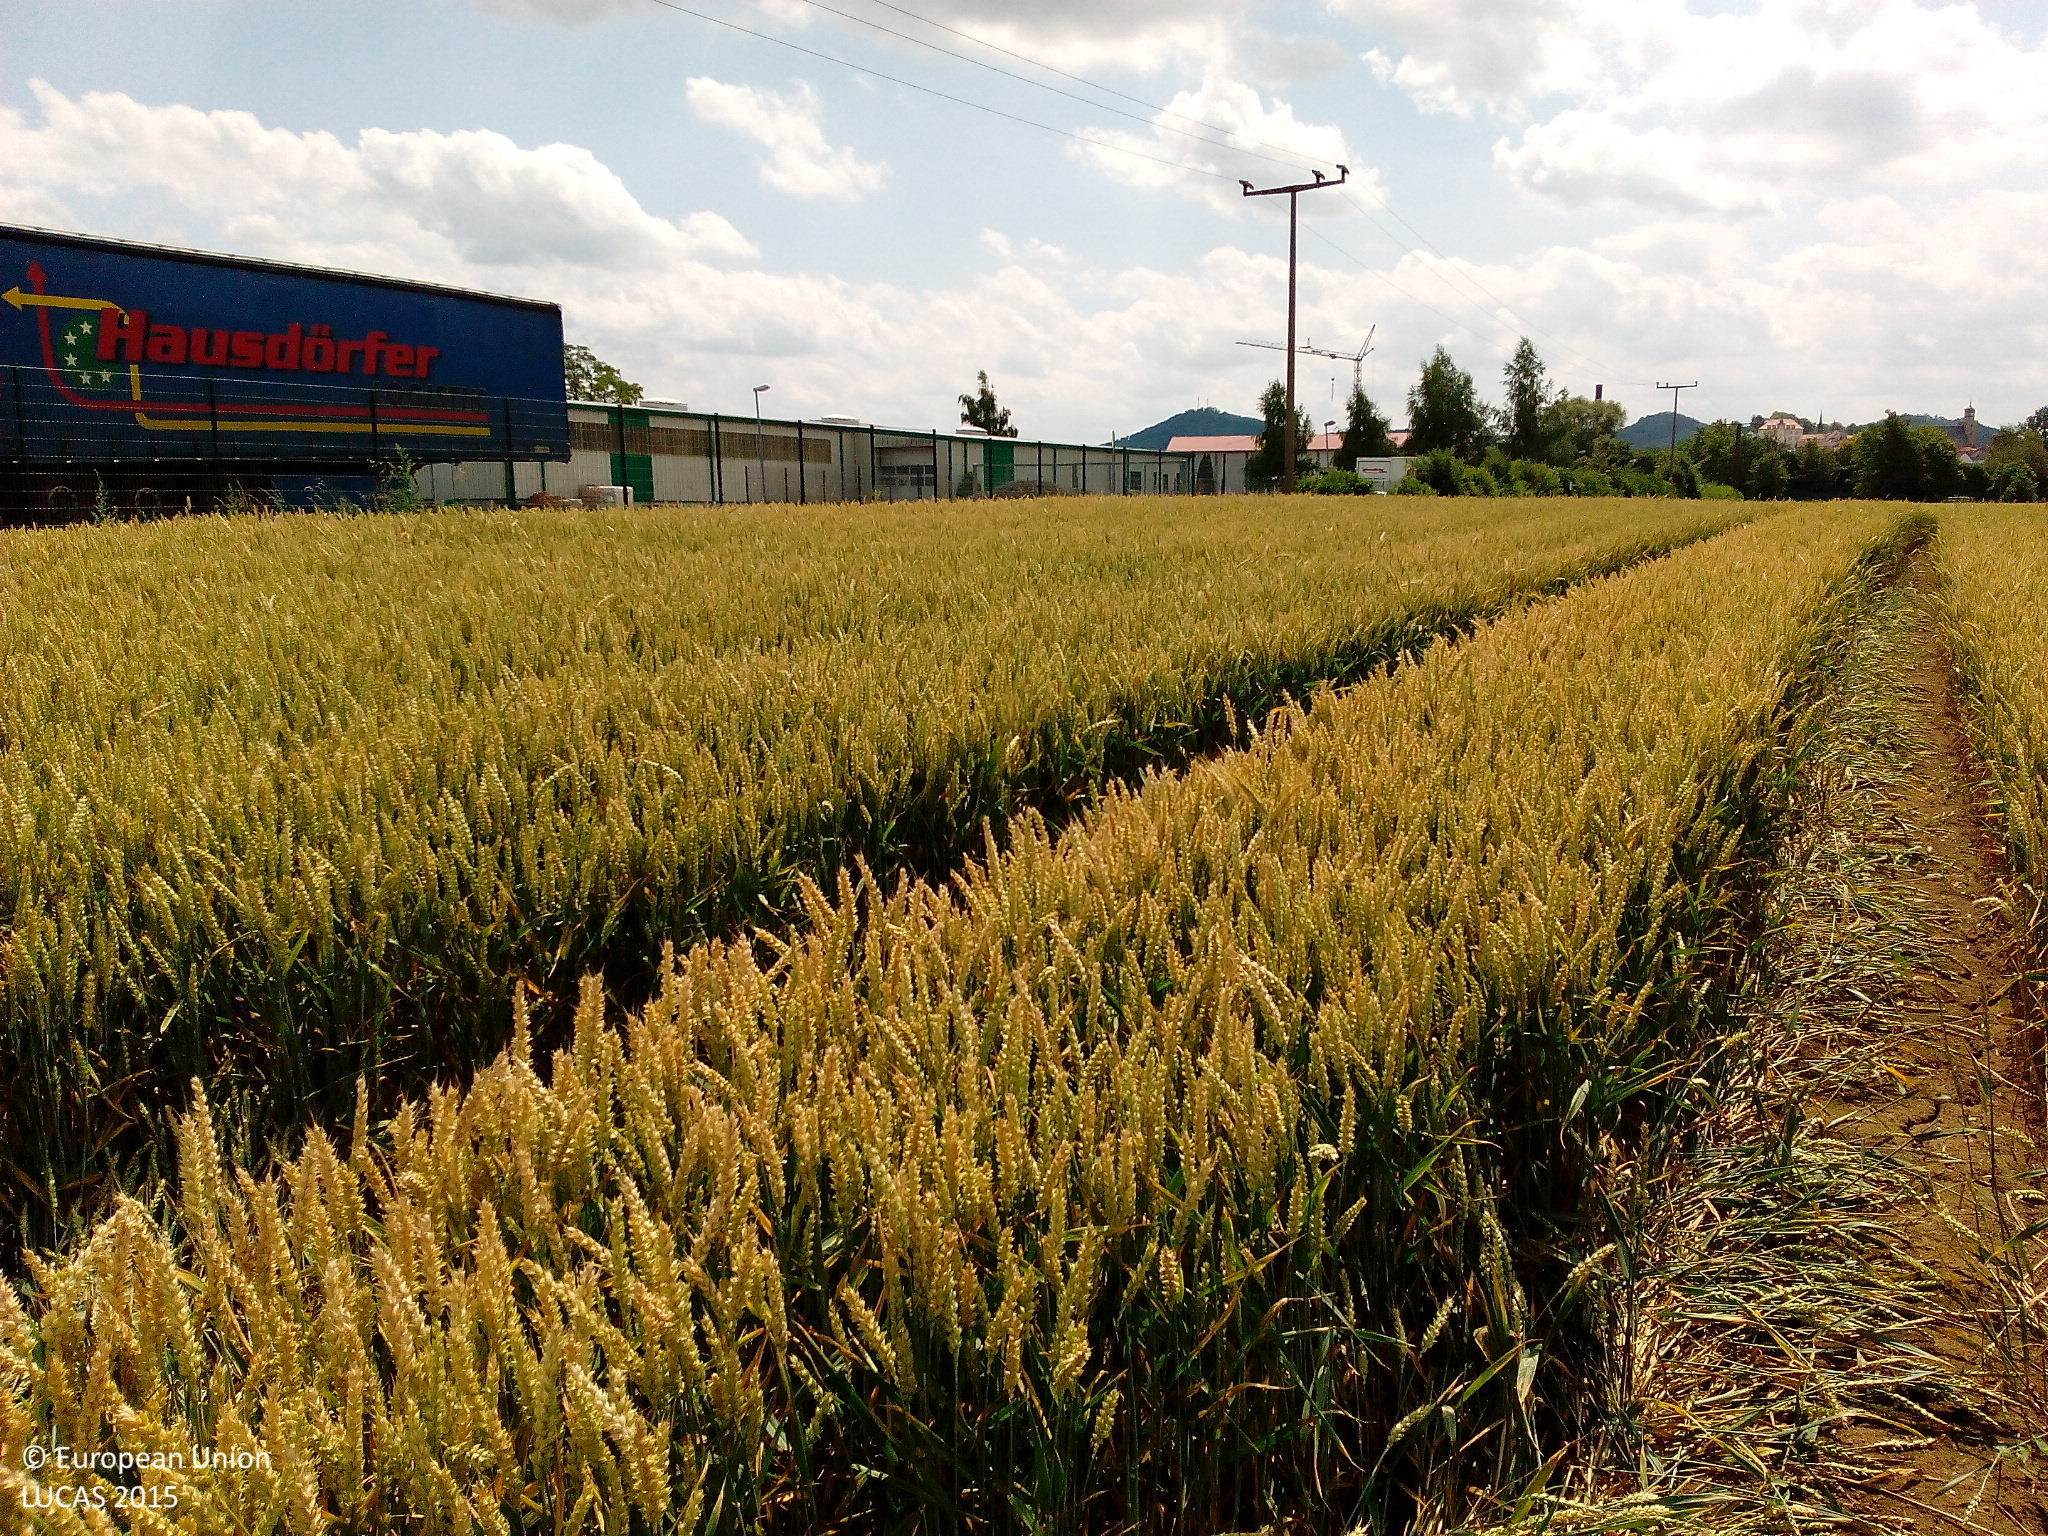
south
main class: Cropland
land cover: Common wheat
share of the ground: > 75 %
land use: Agriculture (excluding fallow land and kitchen gardens)
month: July
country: DE
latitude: 50.7236
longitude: 9.9575
